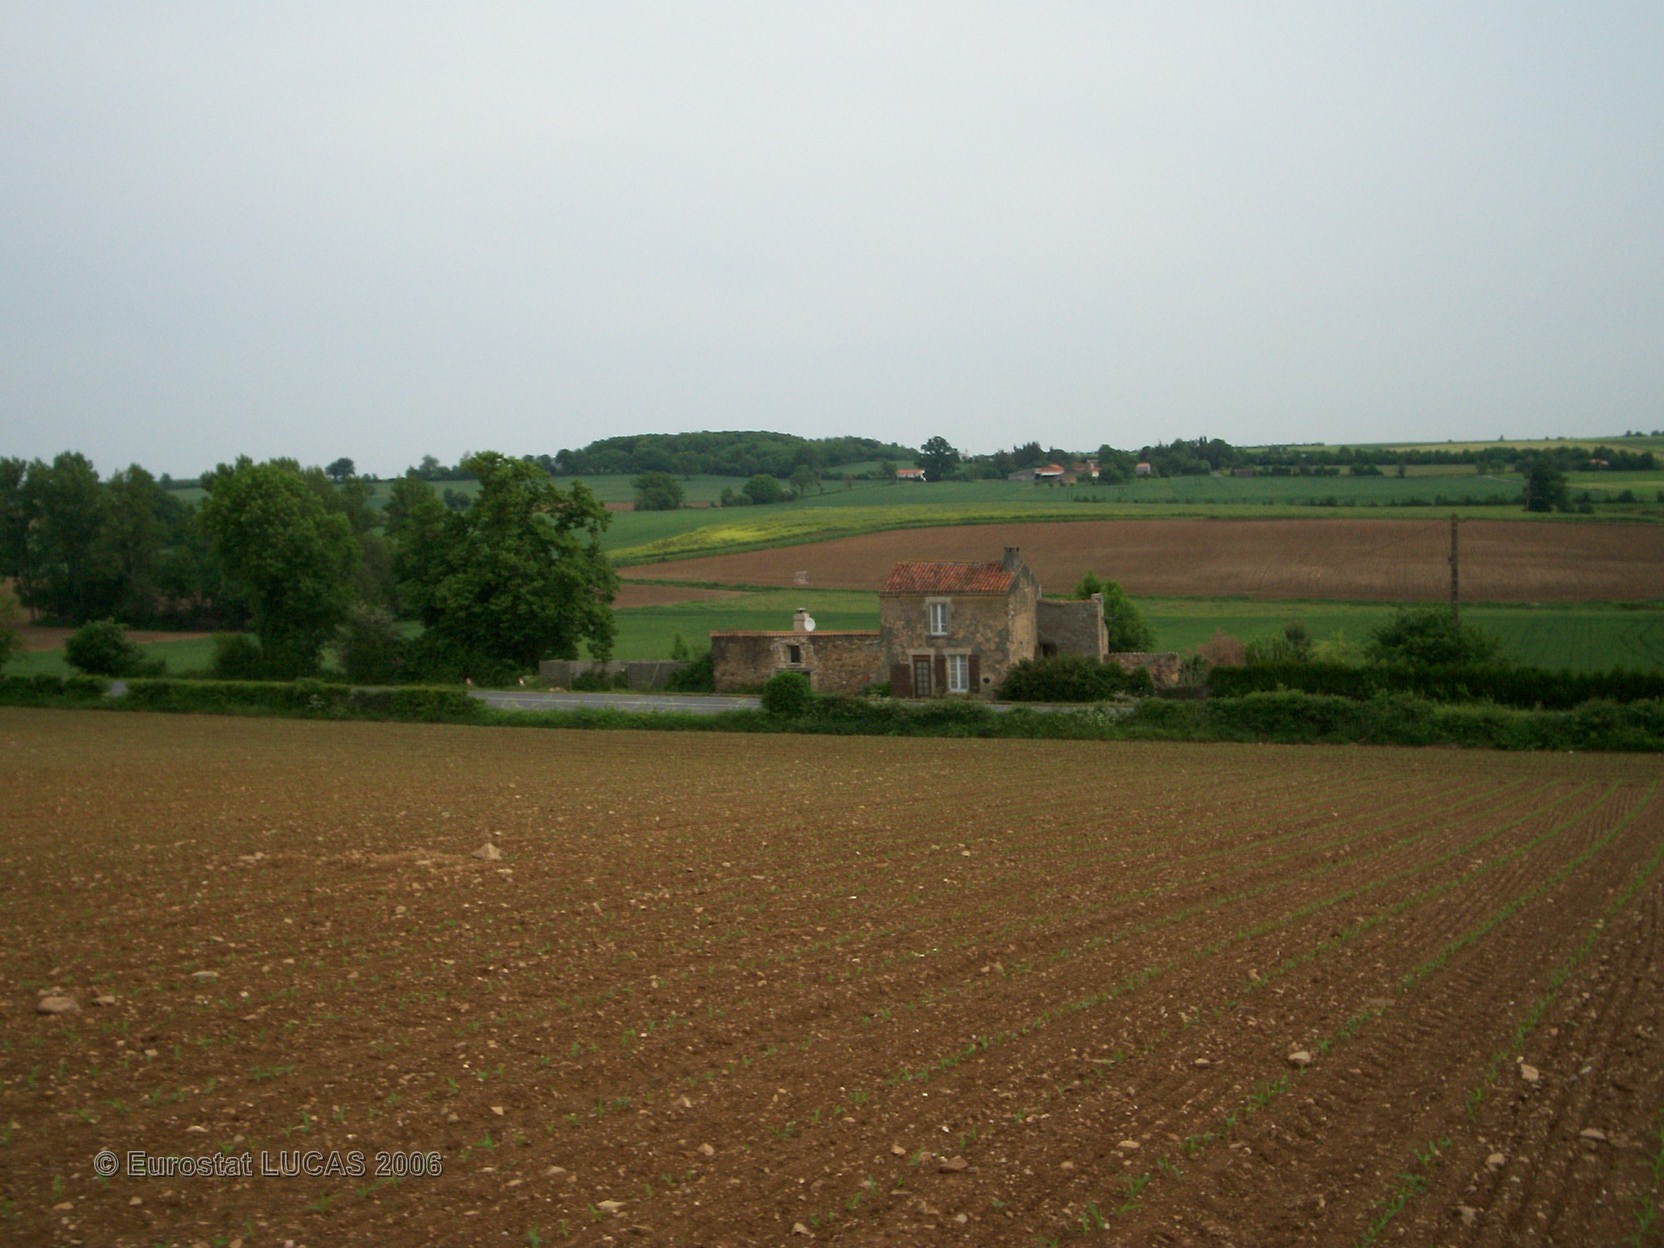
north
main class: Cropland
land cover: Maize
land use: Agriculture (excluding fallow land and kitchen gardens)
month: May
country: FR
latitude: 46.6731
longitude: -0.8149
